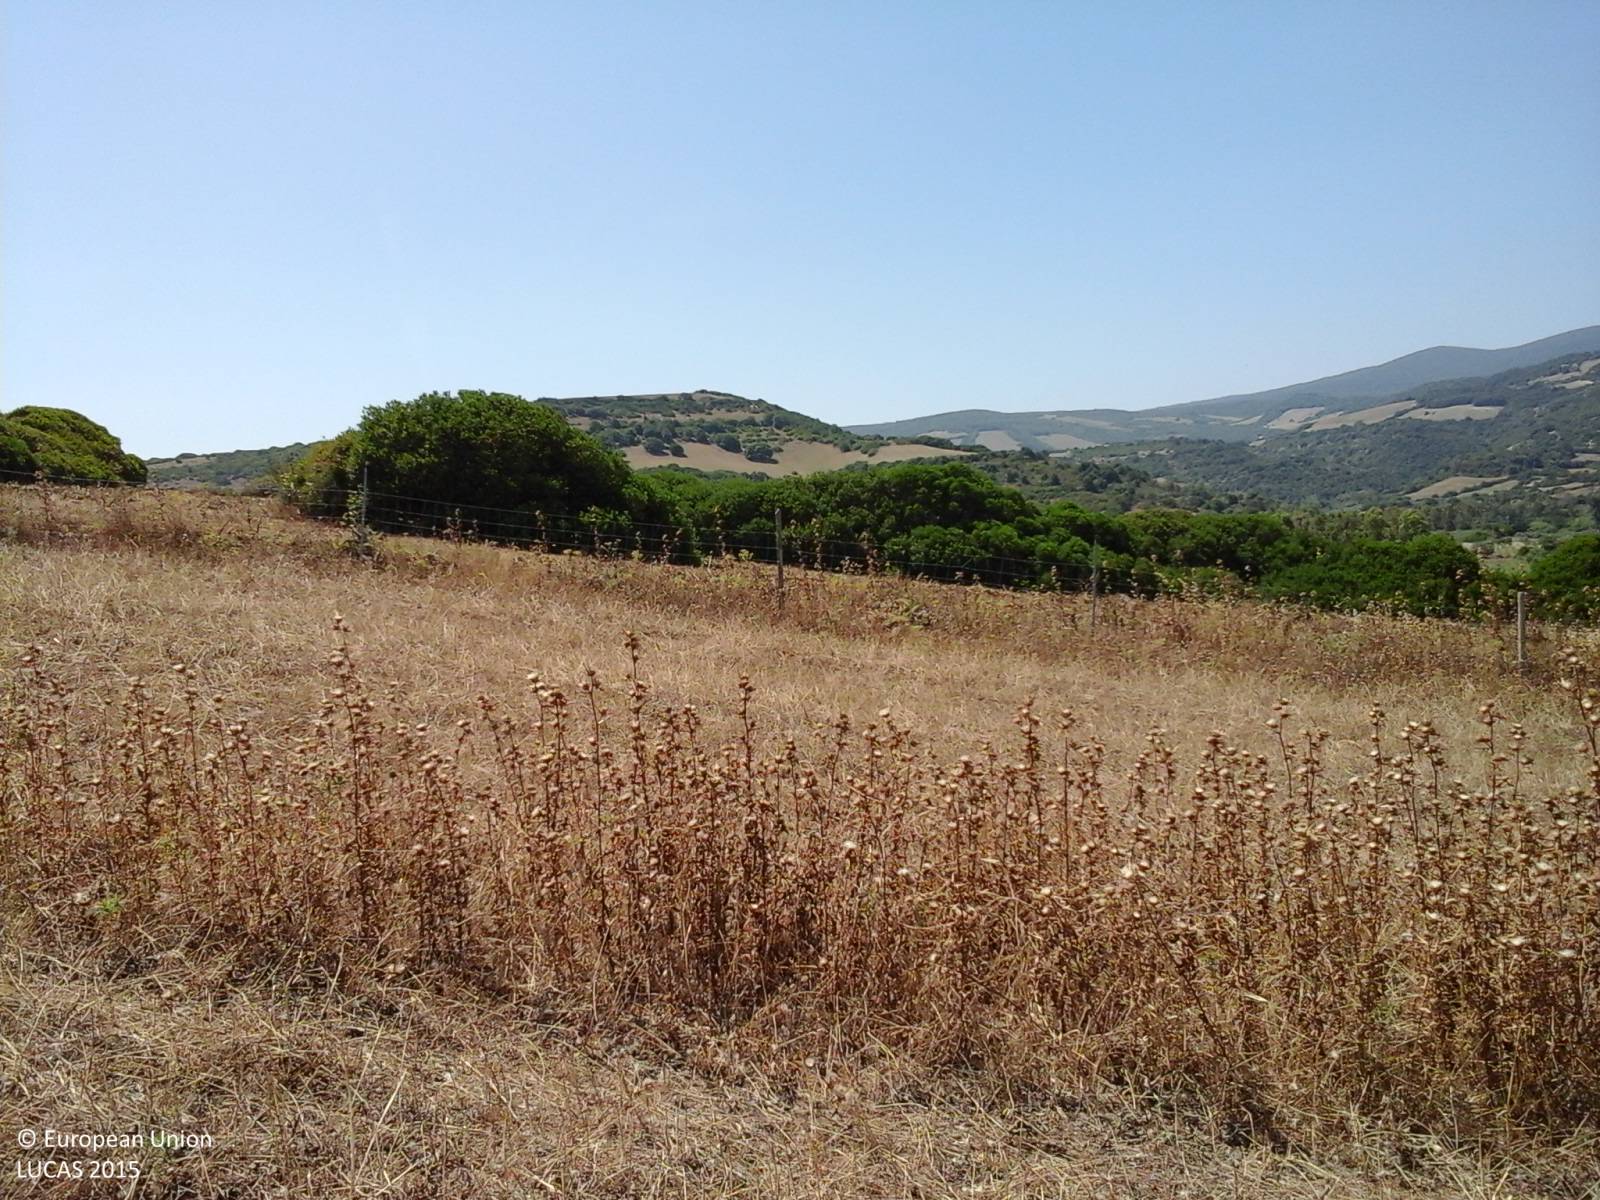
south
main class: Cropland
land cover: Mixed cereals for fodder
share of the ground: > 75 %
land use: Agriculture (excluding fallow land and kitchen gardens)
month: June
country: IT
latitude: 39.8798
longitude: 8.8023
